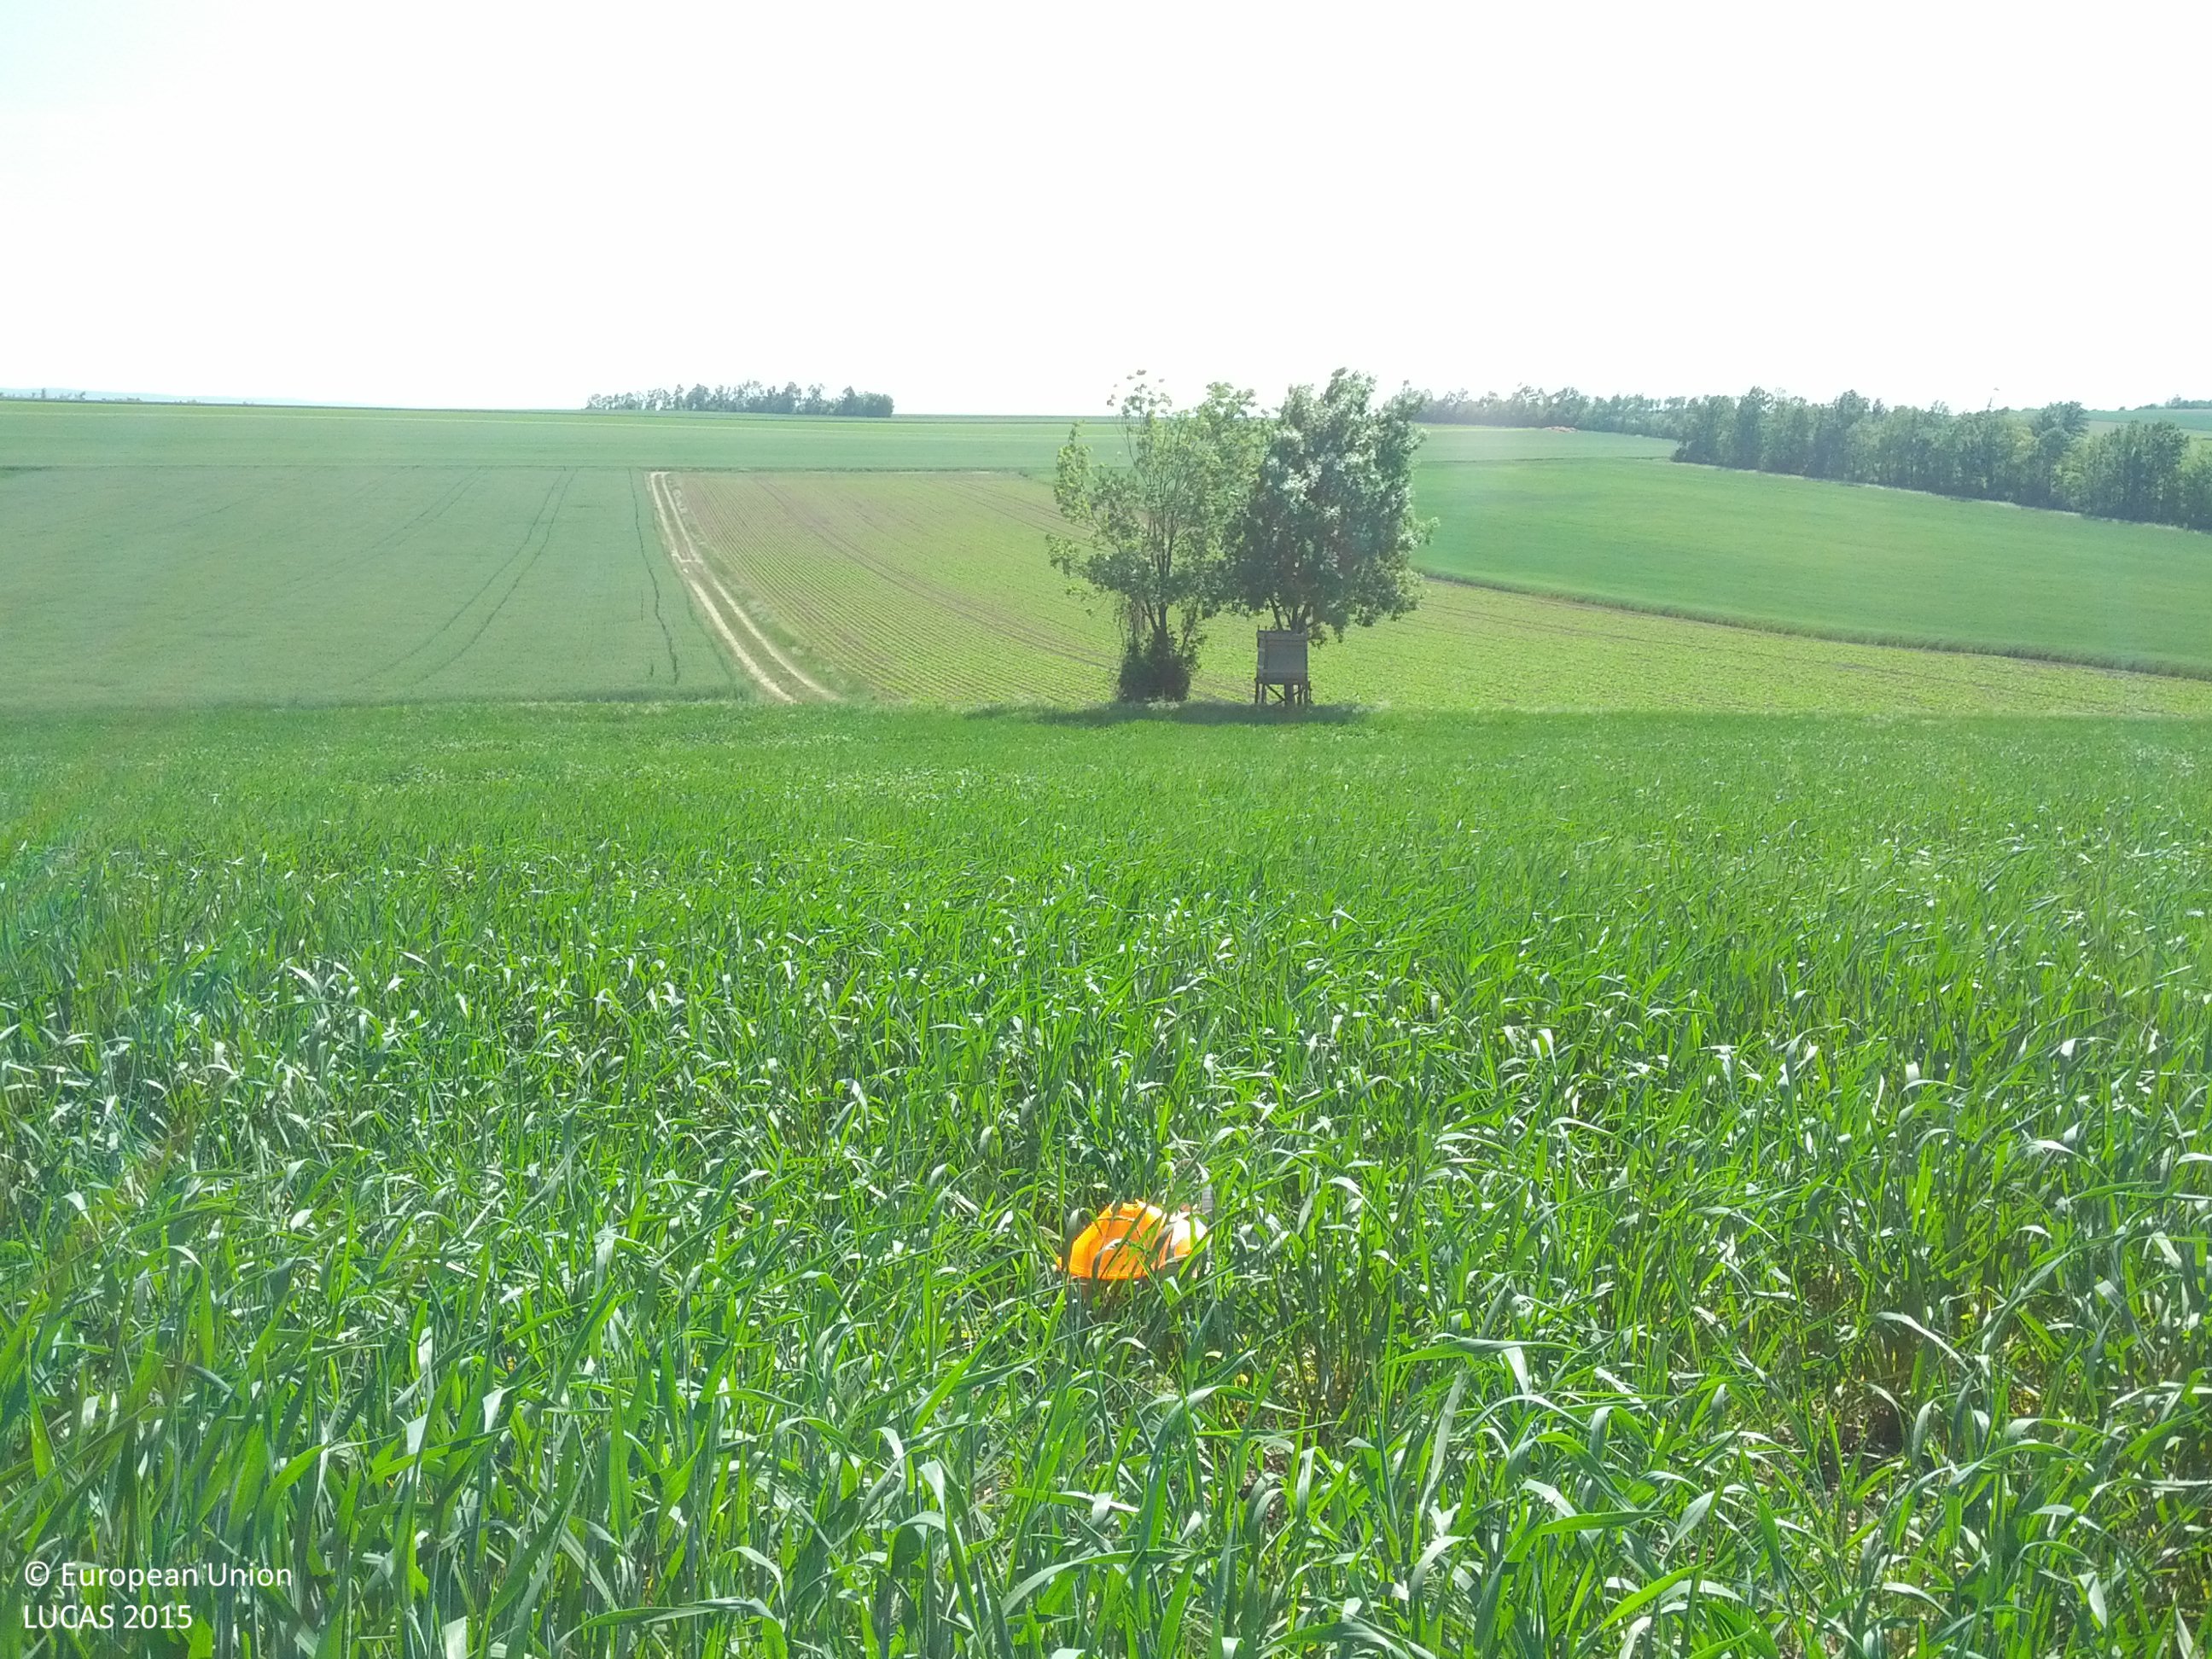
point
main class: Cropland
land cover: Barley
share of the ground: > 75 %
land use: Agriculture (excluding fallow land and kitchen gardens)
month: May
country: AT
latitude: 48.0769
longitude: 16.6499
